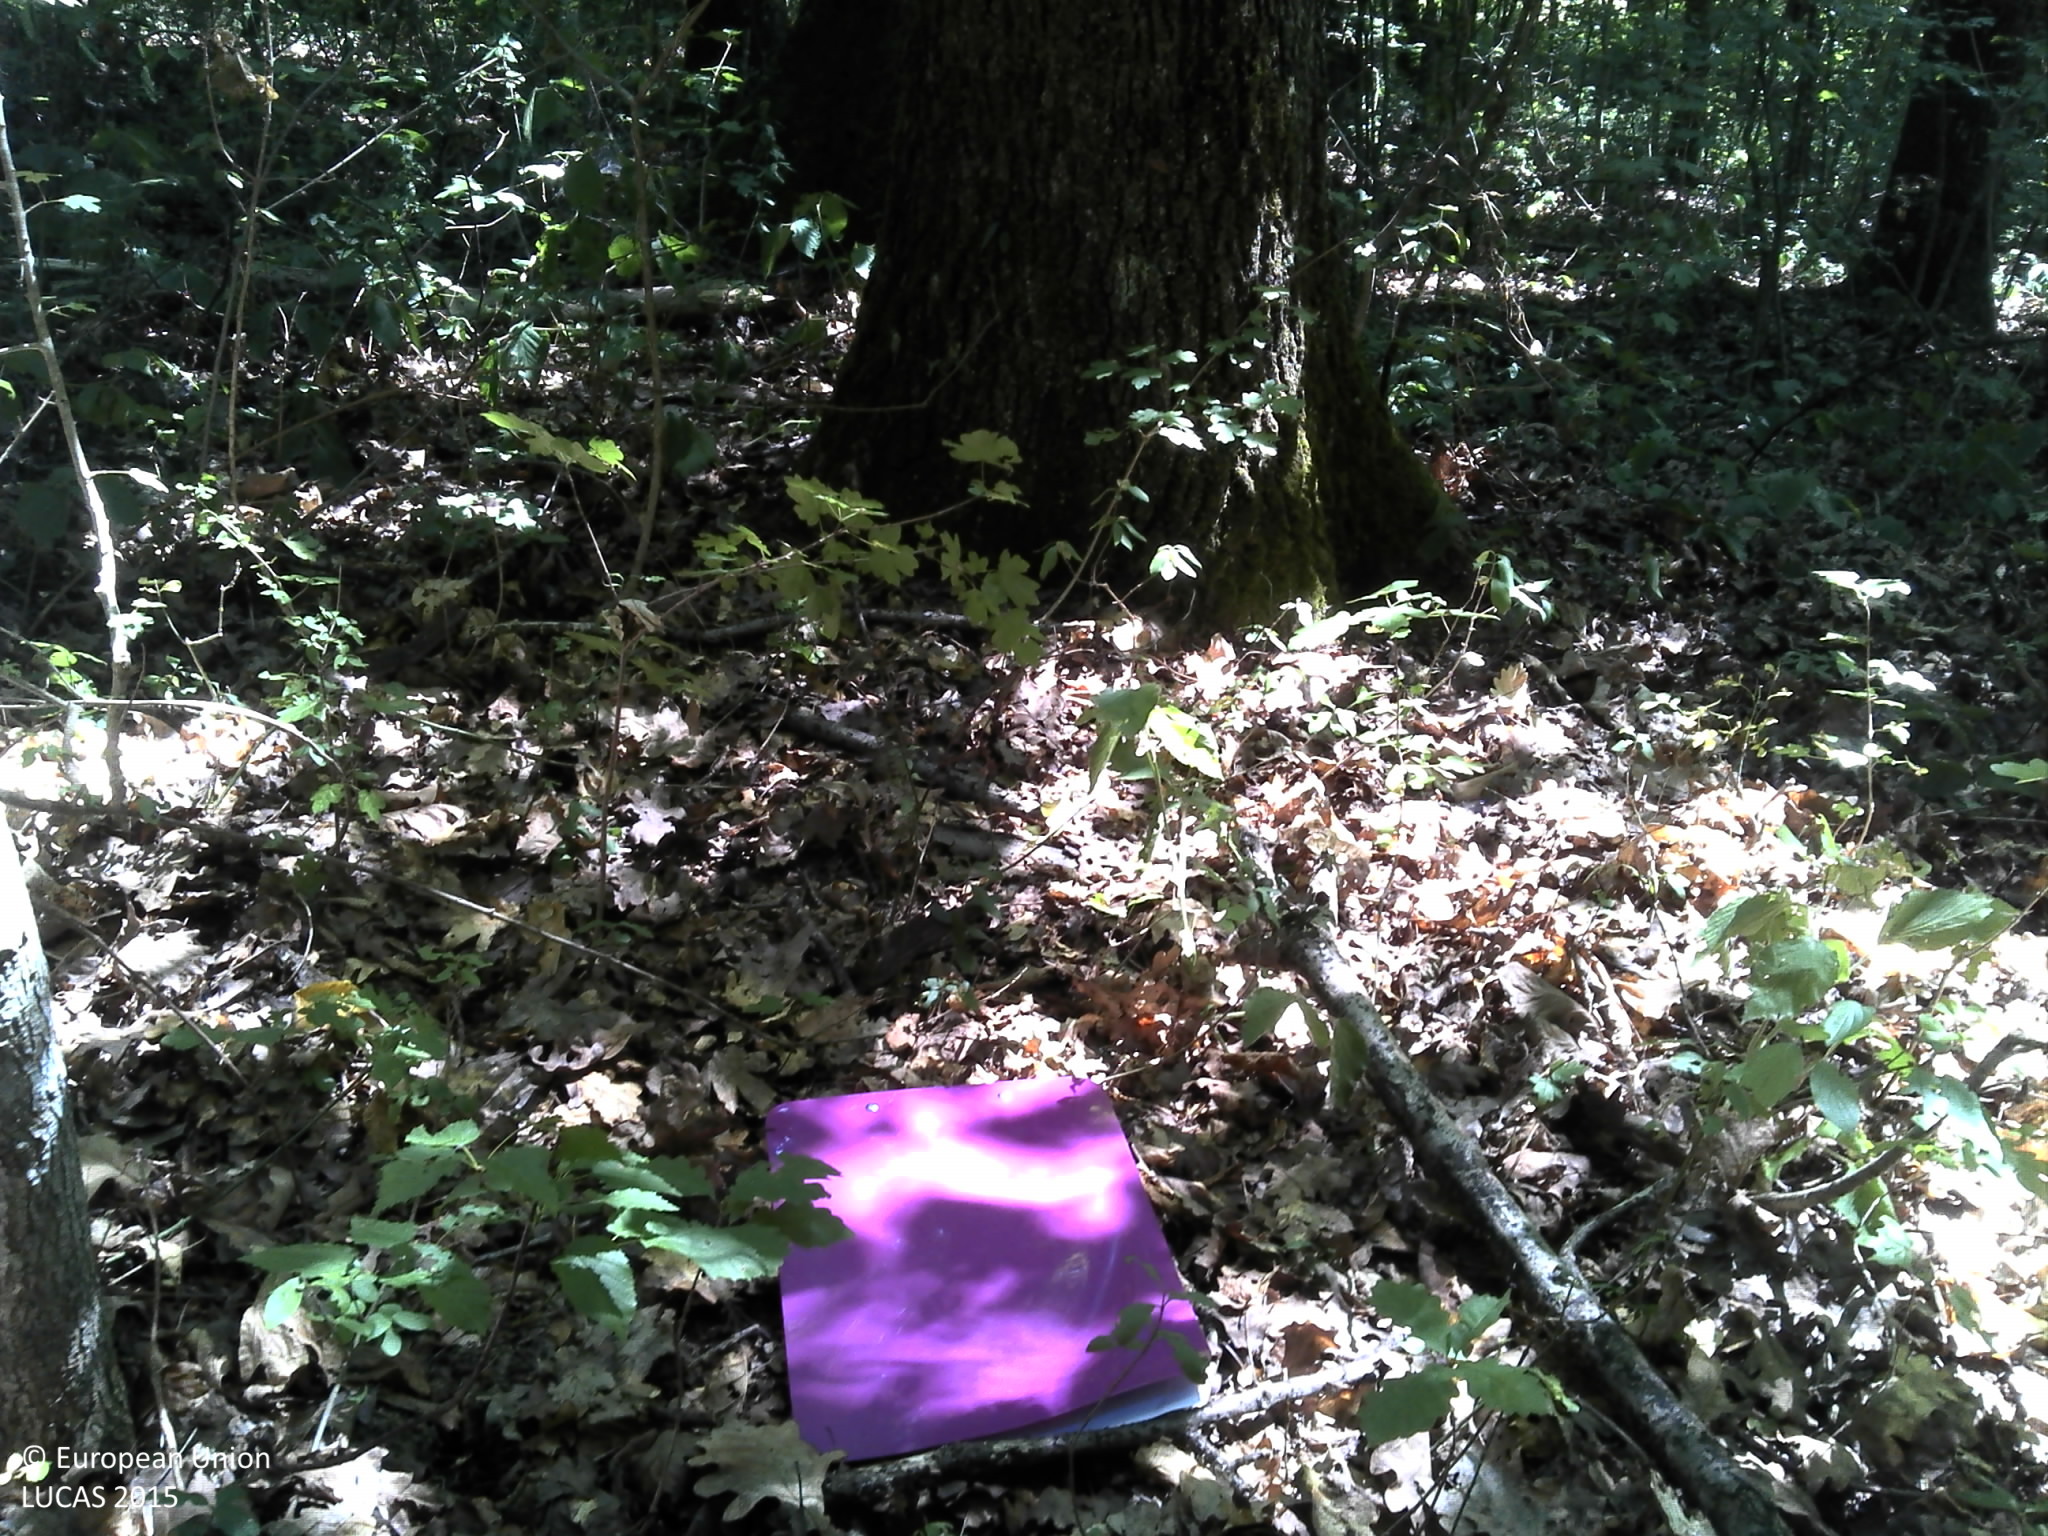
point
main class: Woodland
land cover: Broadleaved woodland
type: acidophilous oak and oak-birch forest
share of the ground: > 75 %
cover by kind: broadleaved forest trees 100 %
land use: Forestry
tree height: > 5 m
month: August
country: HR
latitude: 45.3601
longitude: 16.4701
